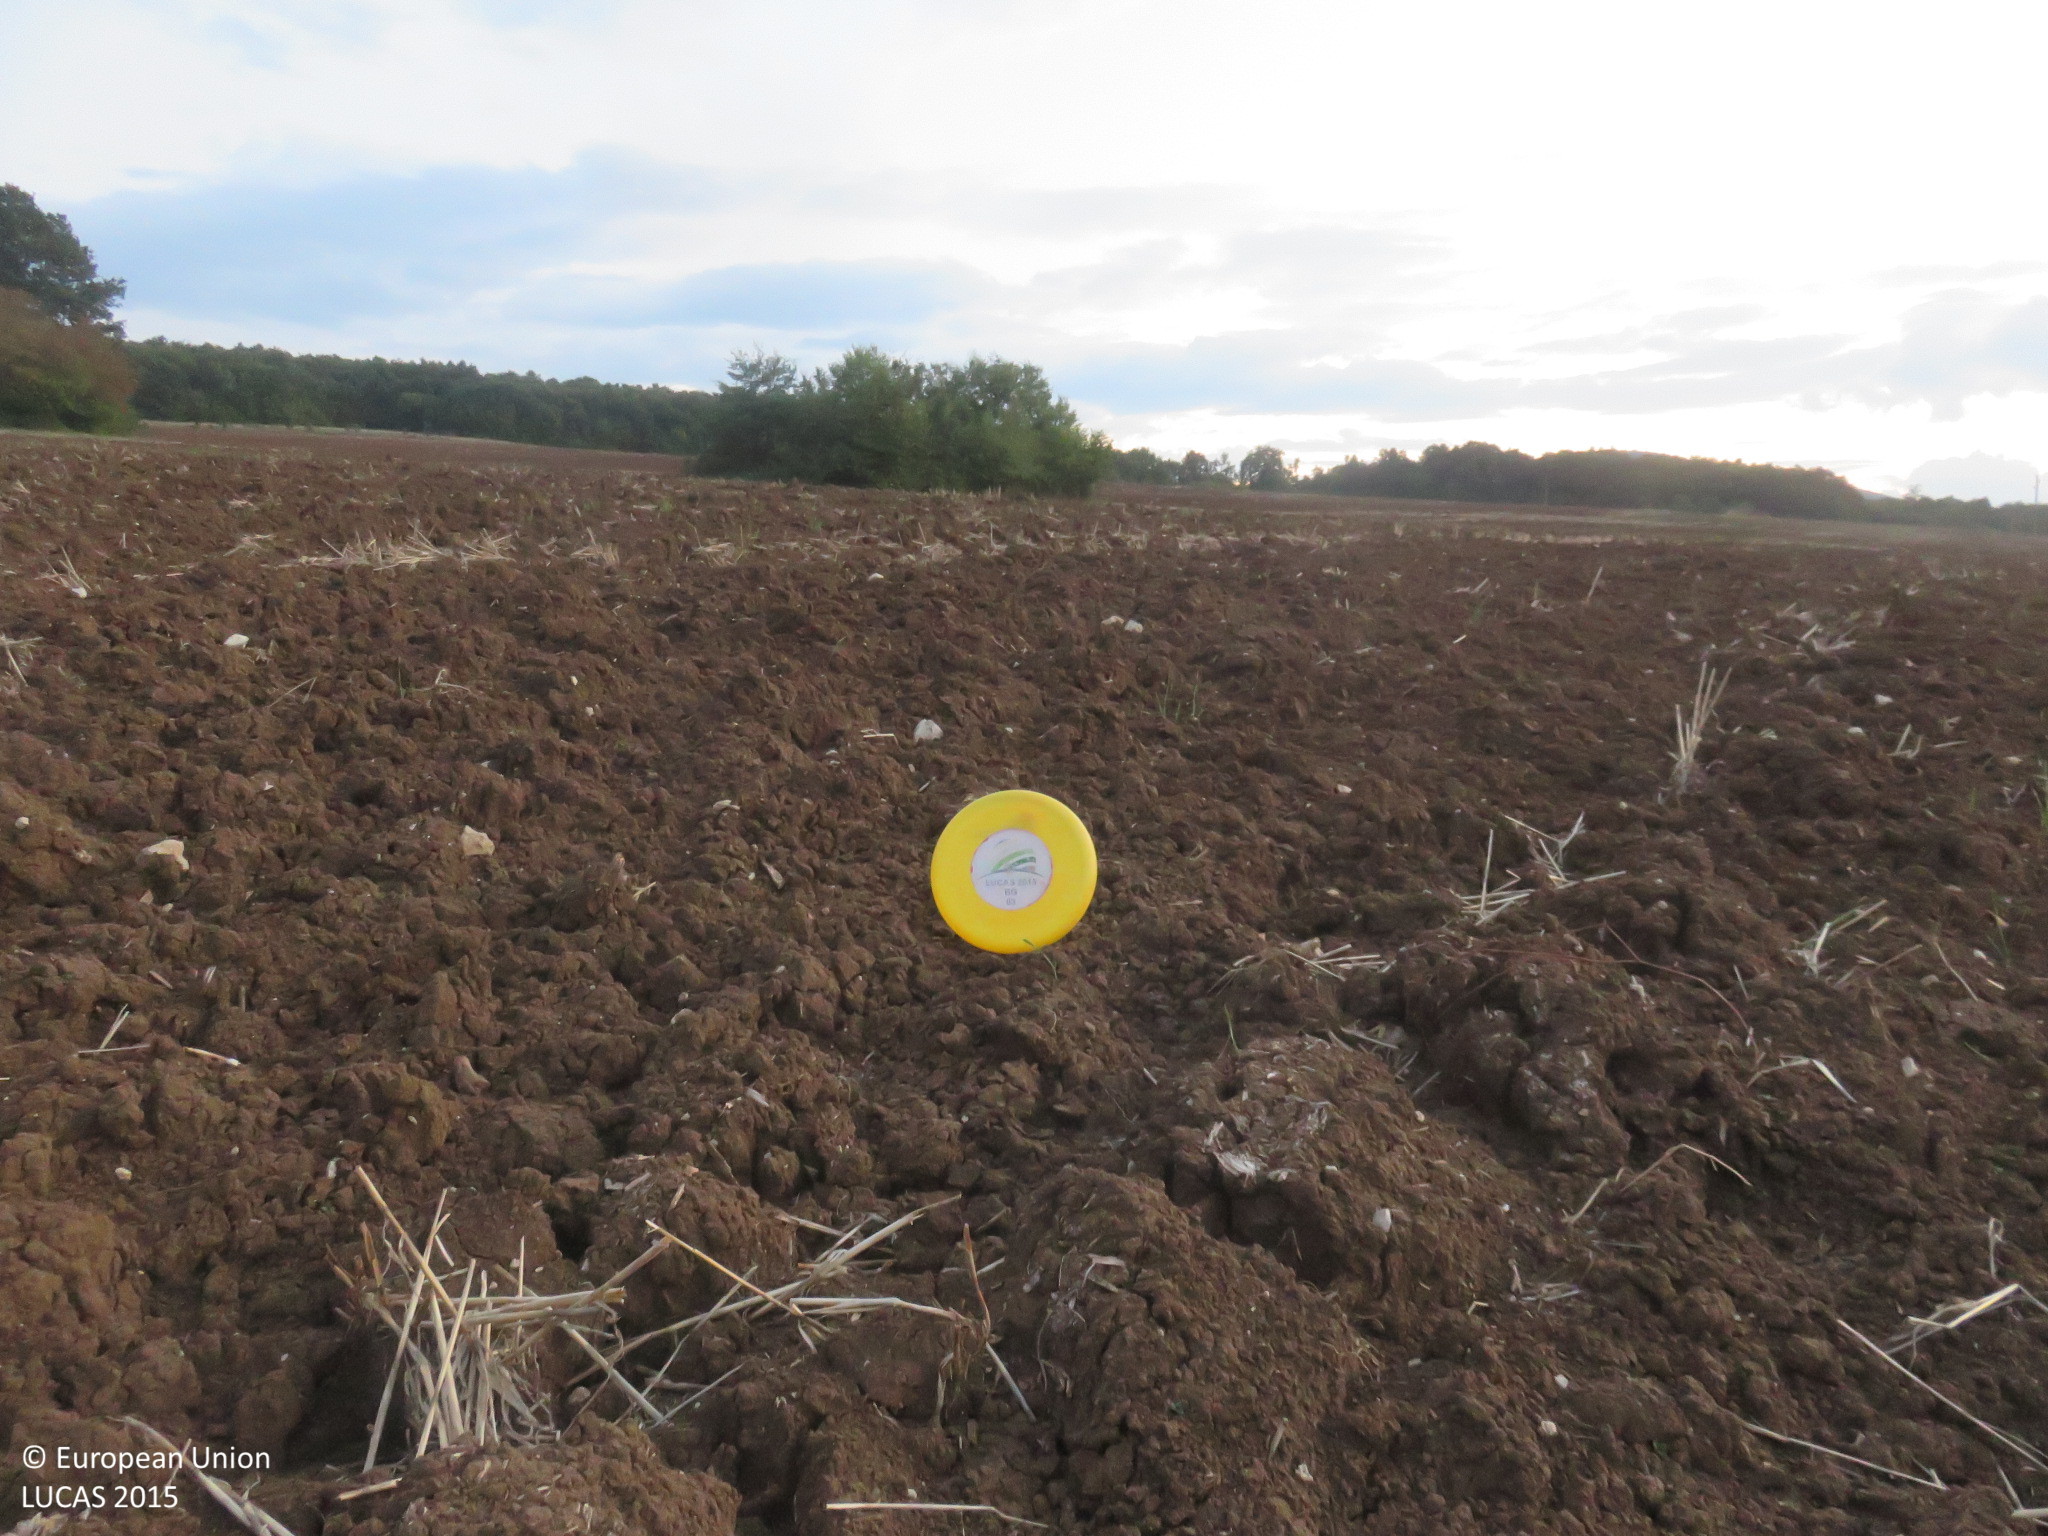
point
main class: Cropland
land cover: Common wheat
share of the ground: < 10 %
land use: Agriculture (excluding fallow land and kitchen gardens)
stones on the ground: < 10 %
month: September
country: BG
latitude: 43.0679
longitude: 25.0119
